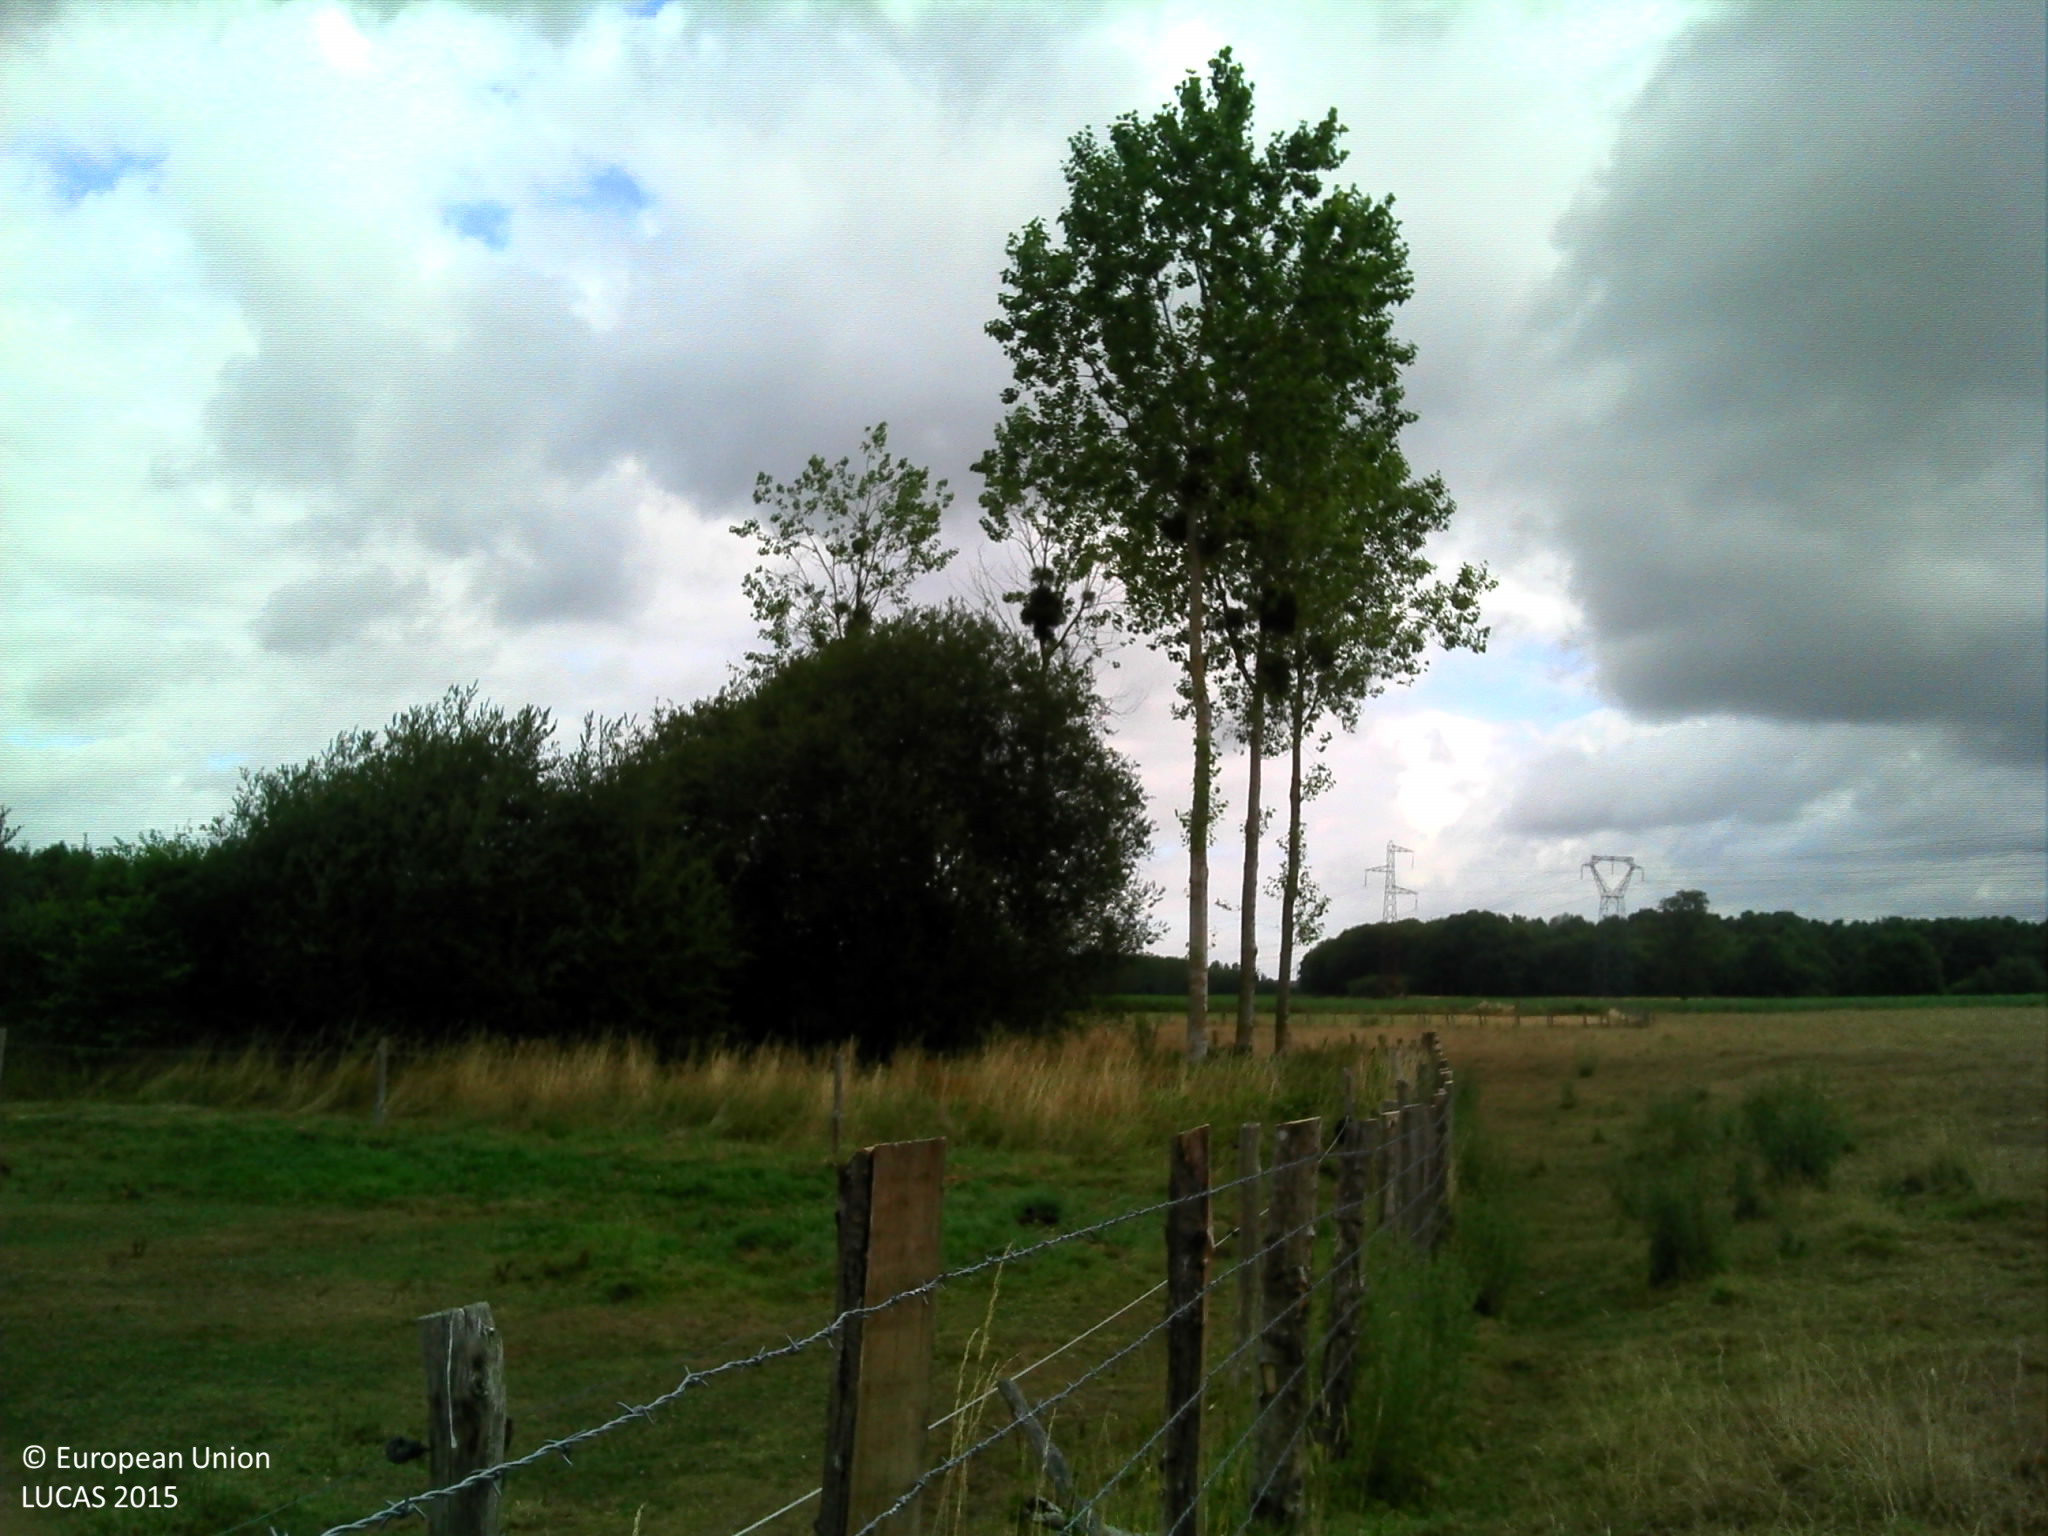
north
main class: Grassland
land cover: Grassland without tree/shrub cover
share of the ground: > 75 %
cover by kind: herbaceous plants 100 %
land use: Agriculture (excluding fallow land and kitchen gardens)
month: July
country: FR
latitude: 47.8077
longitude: 0.2406
